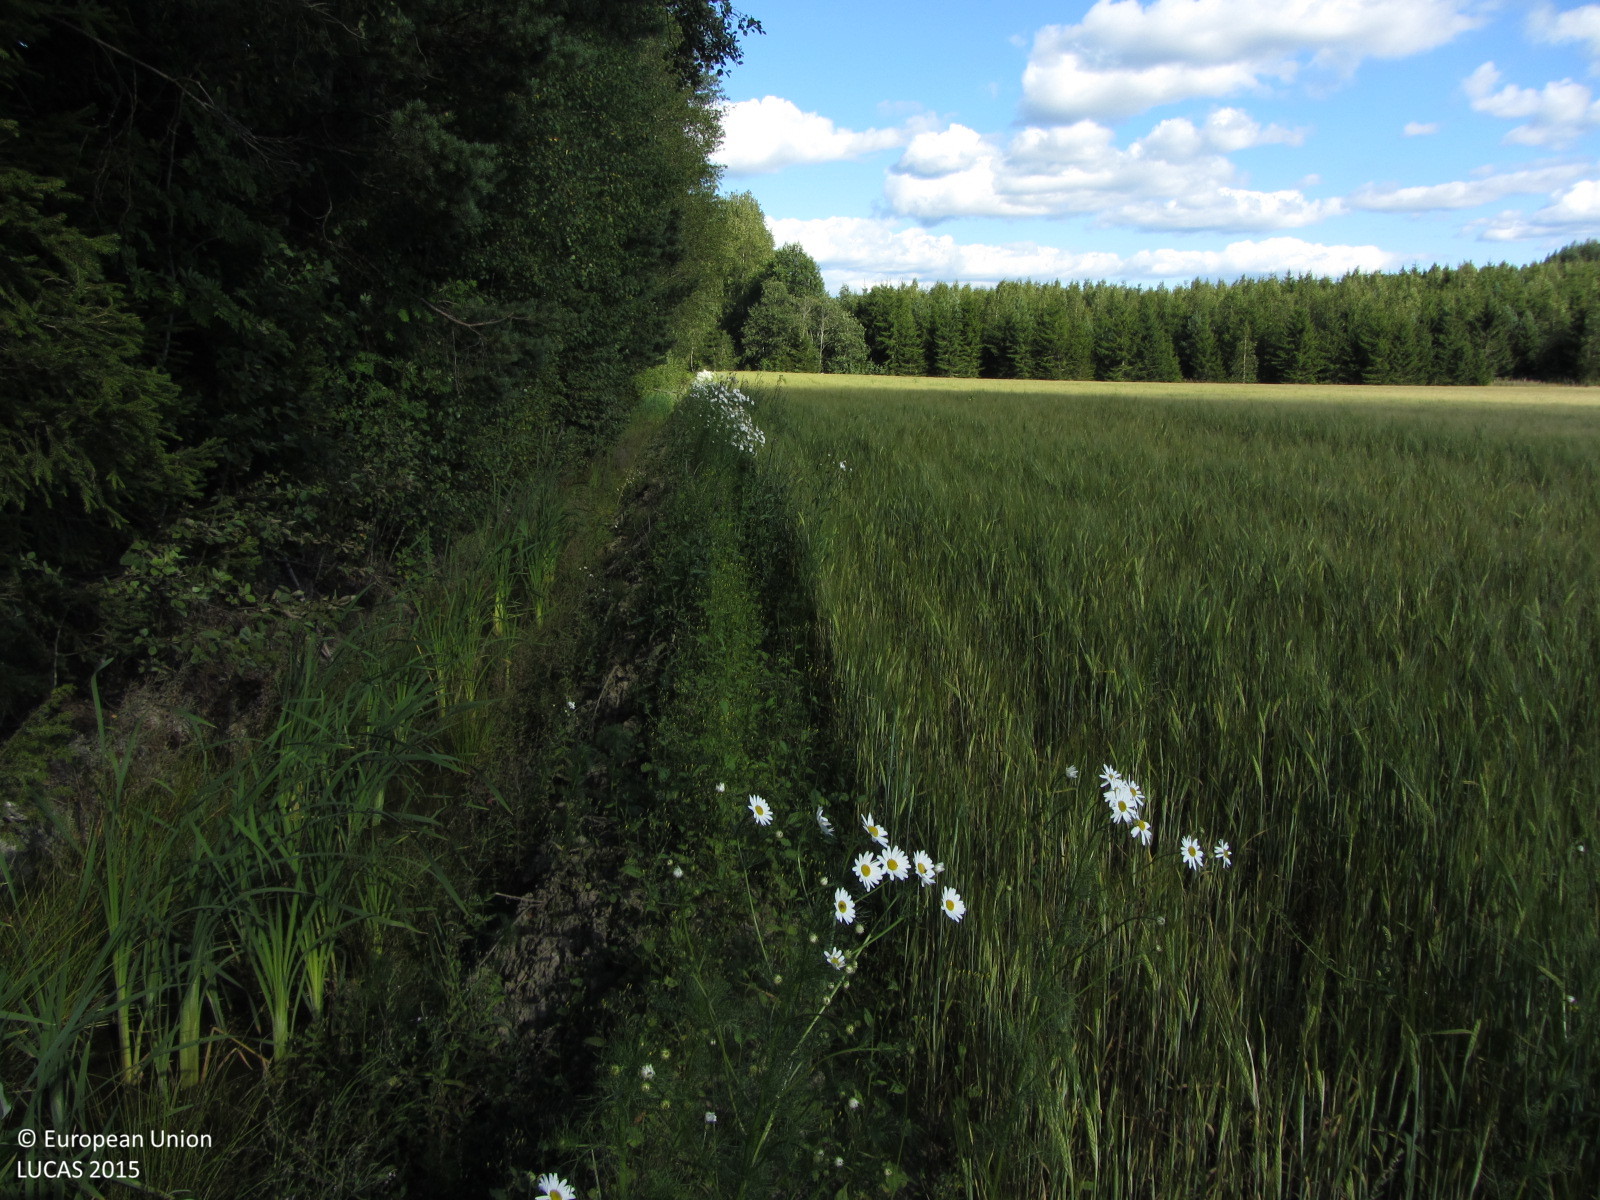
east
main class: Cropland
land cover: Barley
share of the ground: > 75 %
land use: Agriculture (excluding fallow land and kitchen gardens)
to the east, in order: Barley; Grass margins; Ditches and canals; Spruce dominated mixed woodland
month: August
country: FI
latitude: 60.4771
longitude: 23.9026
